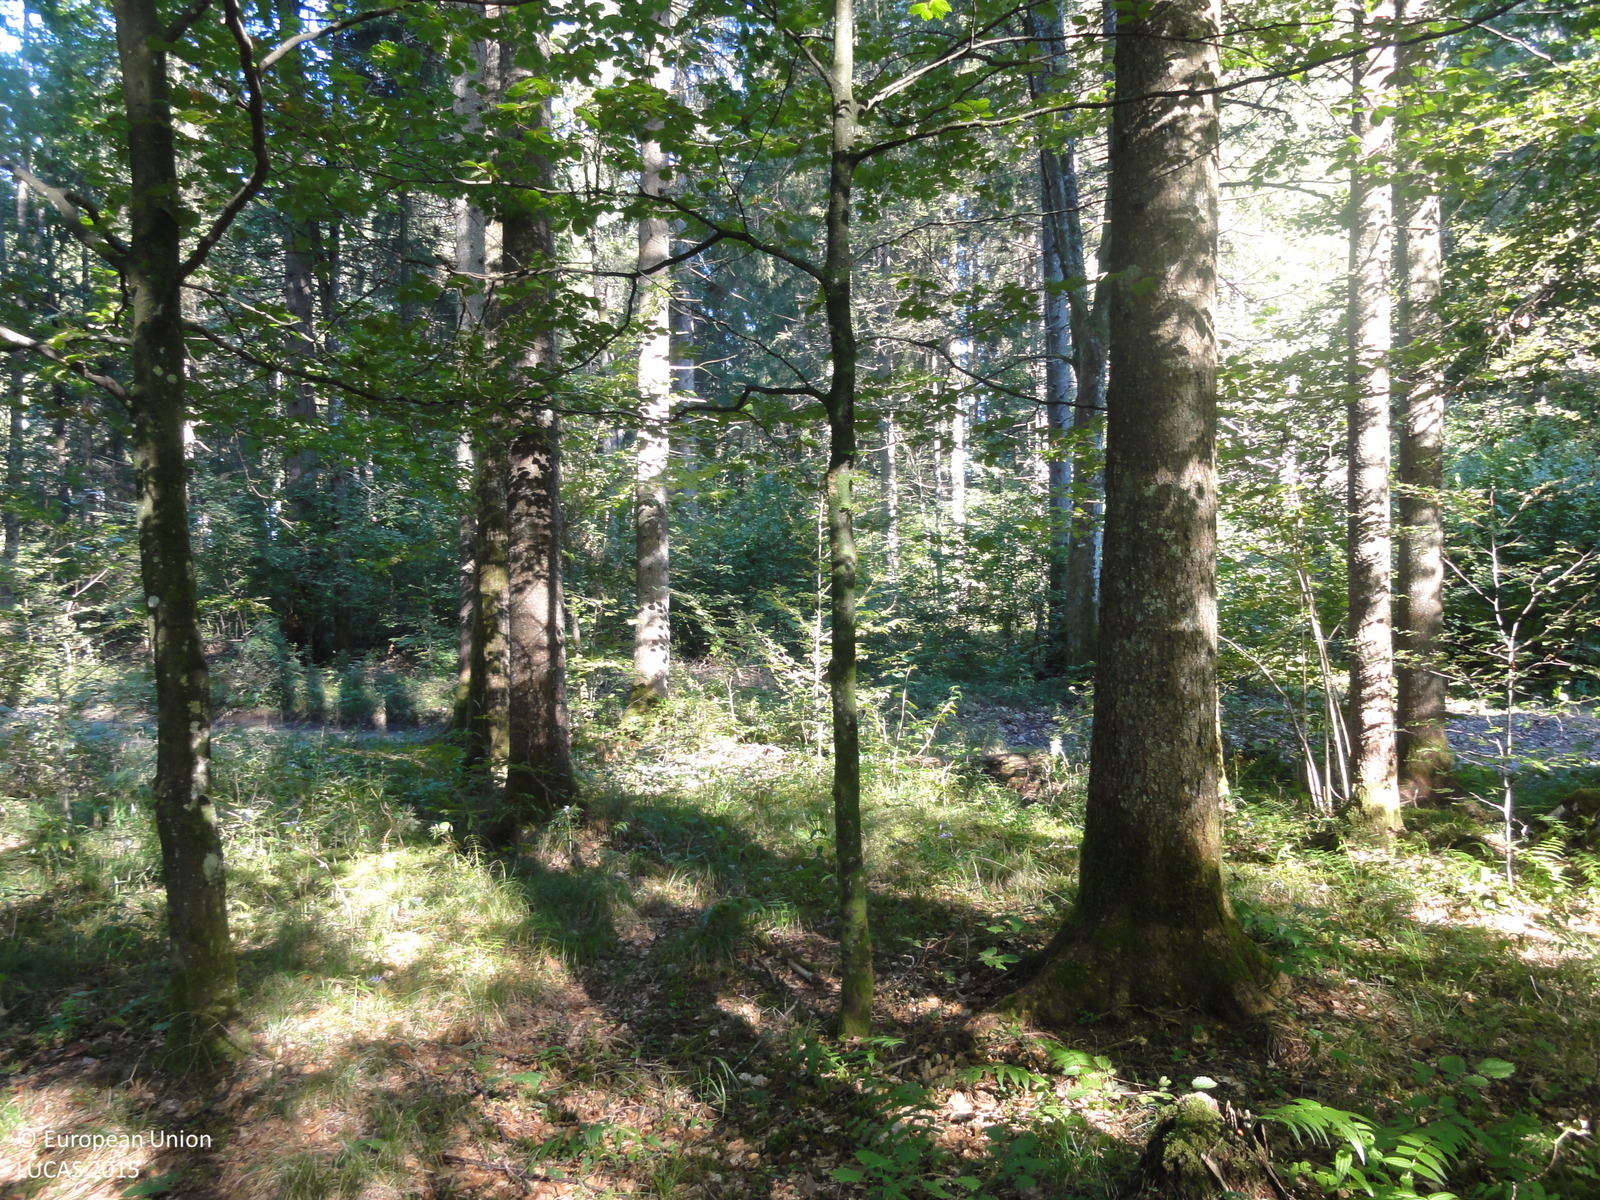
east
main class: Woodland
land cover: Spruce dominated mixed woodland
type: mountainous beech forest
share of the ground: > 75 %
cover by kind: coniferous forest trees 55 %, broadleaved forest trees 30 %, herbaceous plants 10 %, unconsolidated bare surface 5 %
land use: Forestry
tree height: > 5 m
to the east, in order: Spruce dominated mixed woodland; Tracks; Spruce dominated mixed woodland; Spruce dominated coniferous woodland; Electric lines; Tracks; Shrubland without tree cover; Electric lines; Shrubland without tree cover; Electric lines; Shrubland without tree cover; Tracks
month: September
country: SI
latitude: 45.6836
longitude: 14.8107
